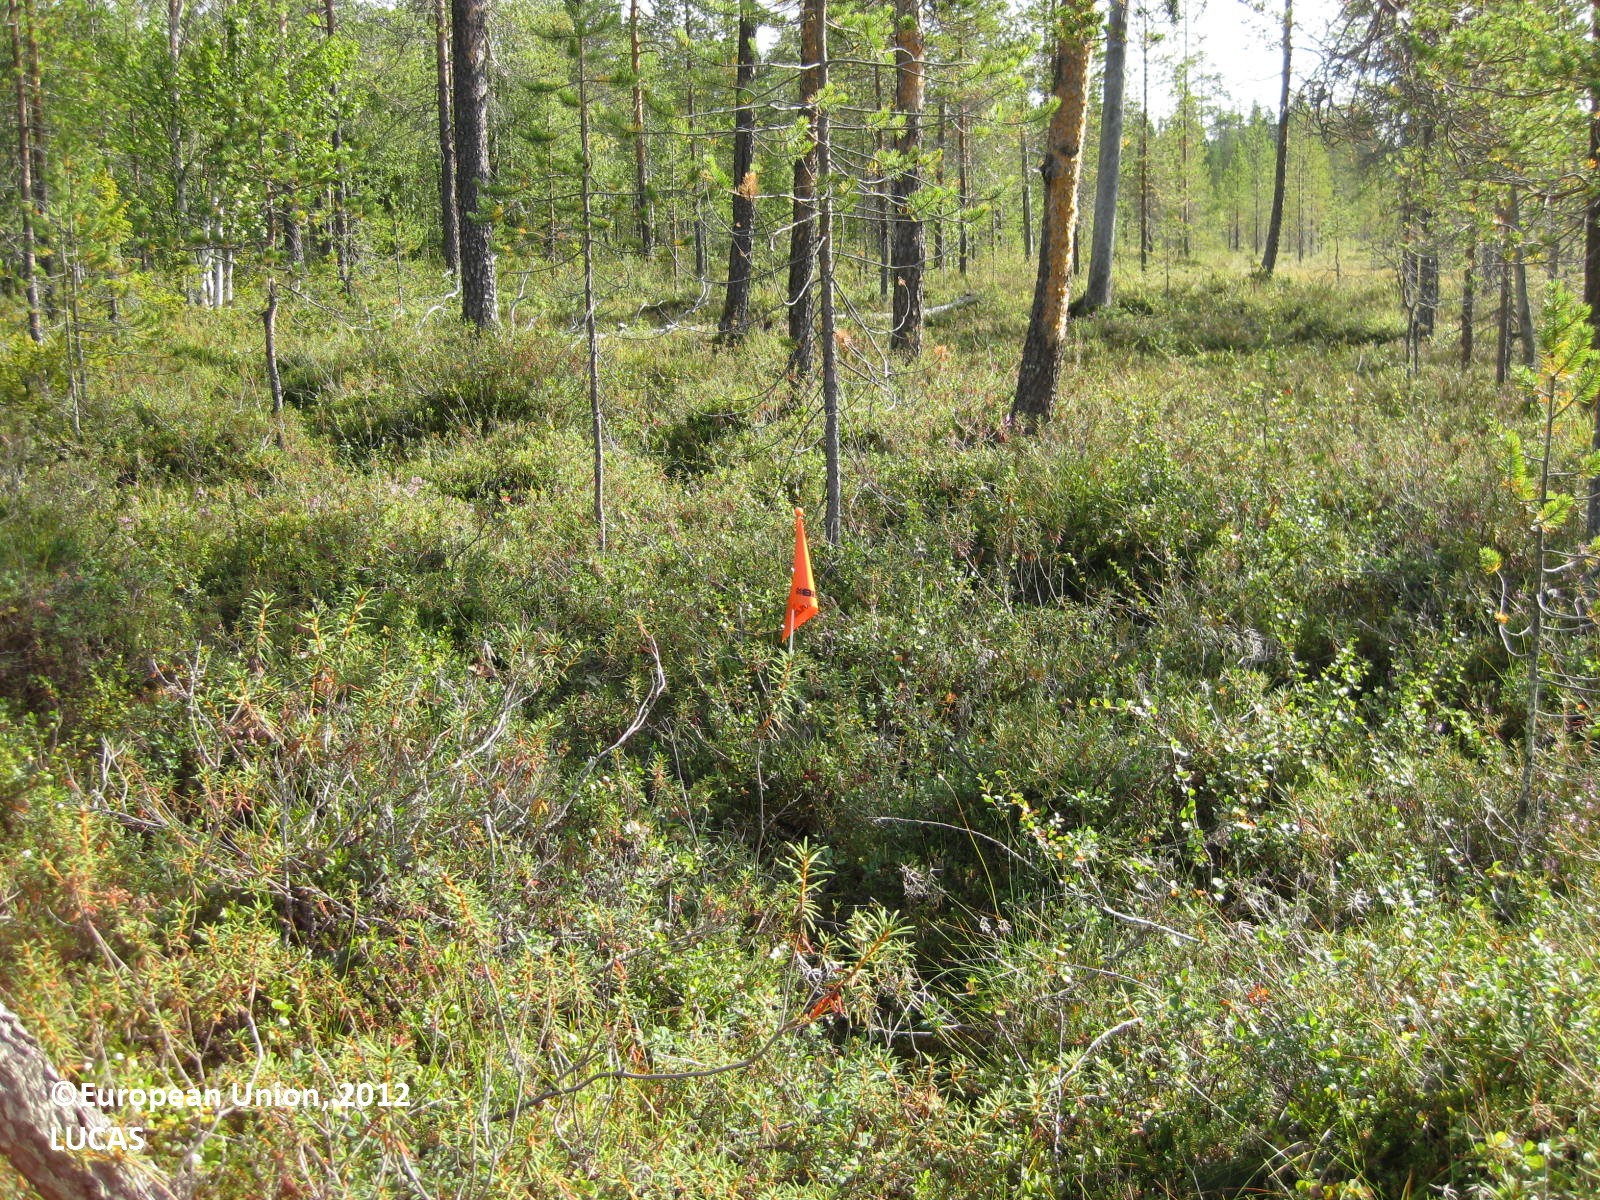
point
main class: Woodland
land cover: Pine dominated coniferous woodland
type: boreal forest
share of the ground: 50 - 75 %
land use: Forestry
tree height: > 5 m
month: August
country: FI
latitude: 66.5432
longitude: 29.0528
